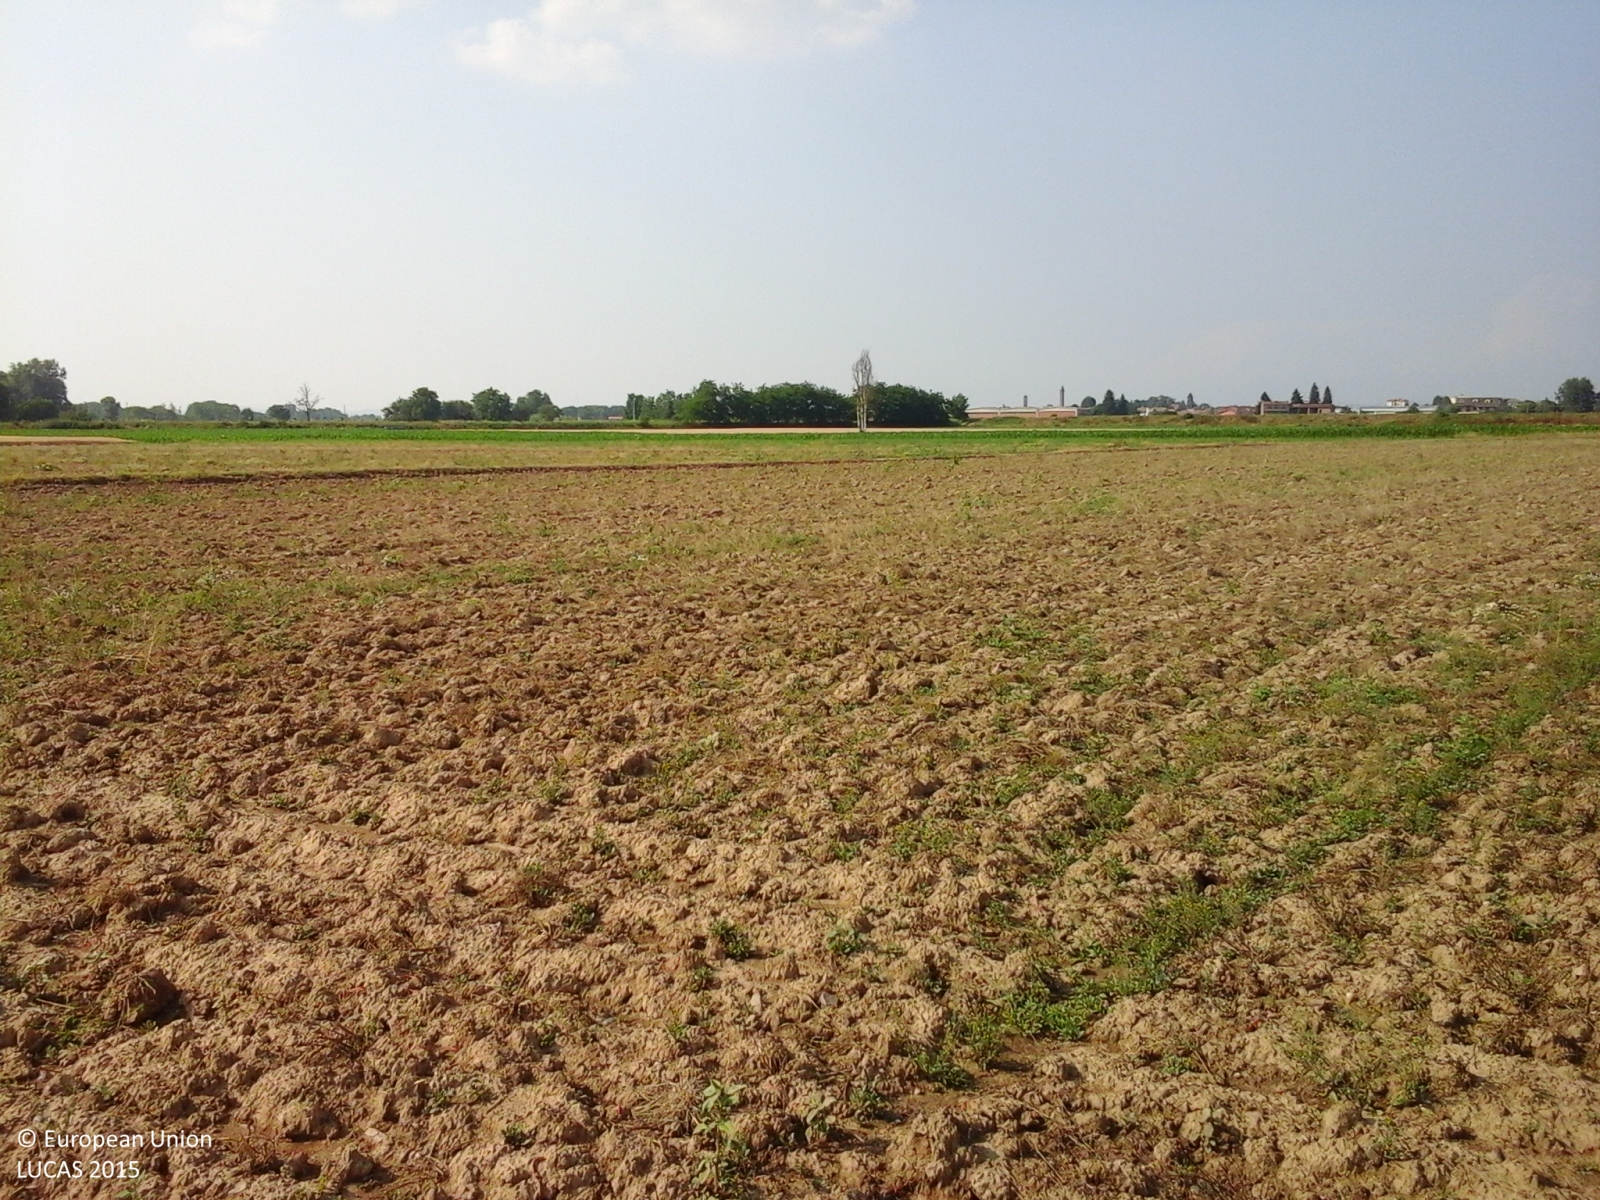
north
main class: Grassland
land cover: Spontaneously vegetated surfaces
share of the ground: > 75 %
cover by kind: herbaceous plants 100 %
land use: Agriculture (excluding fallow land and kitchen gardens)
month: June
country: IT
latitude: 44.8277
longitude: 8.5736
